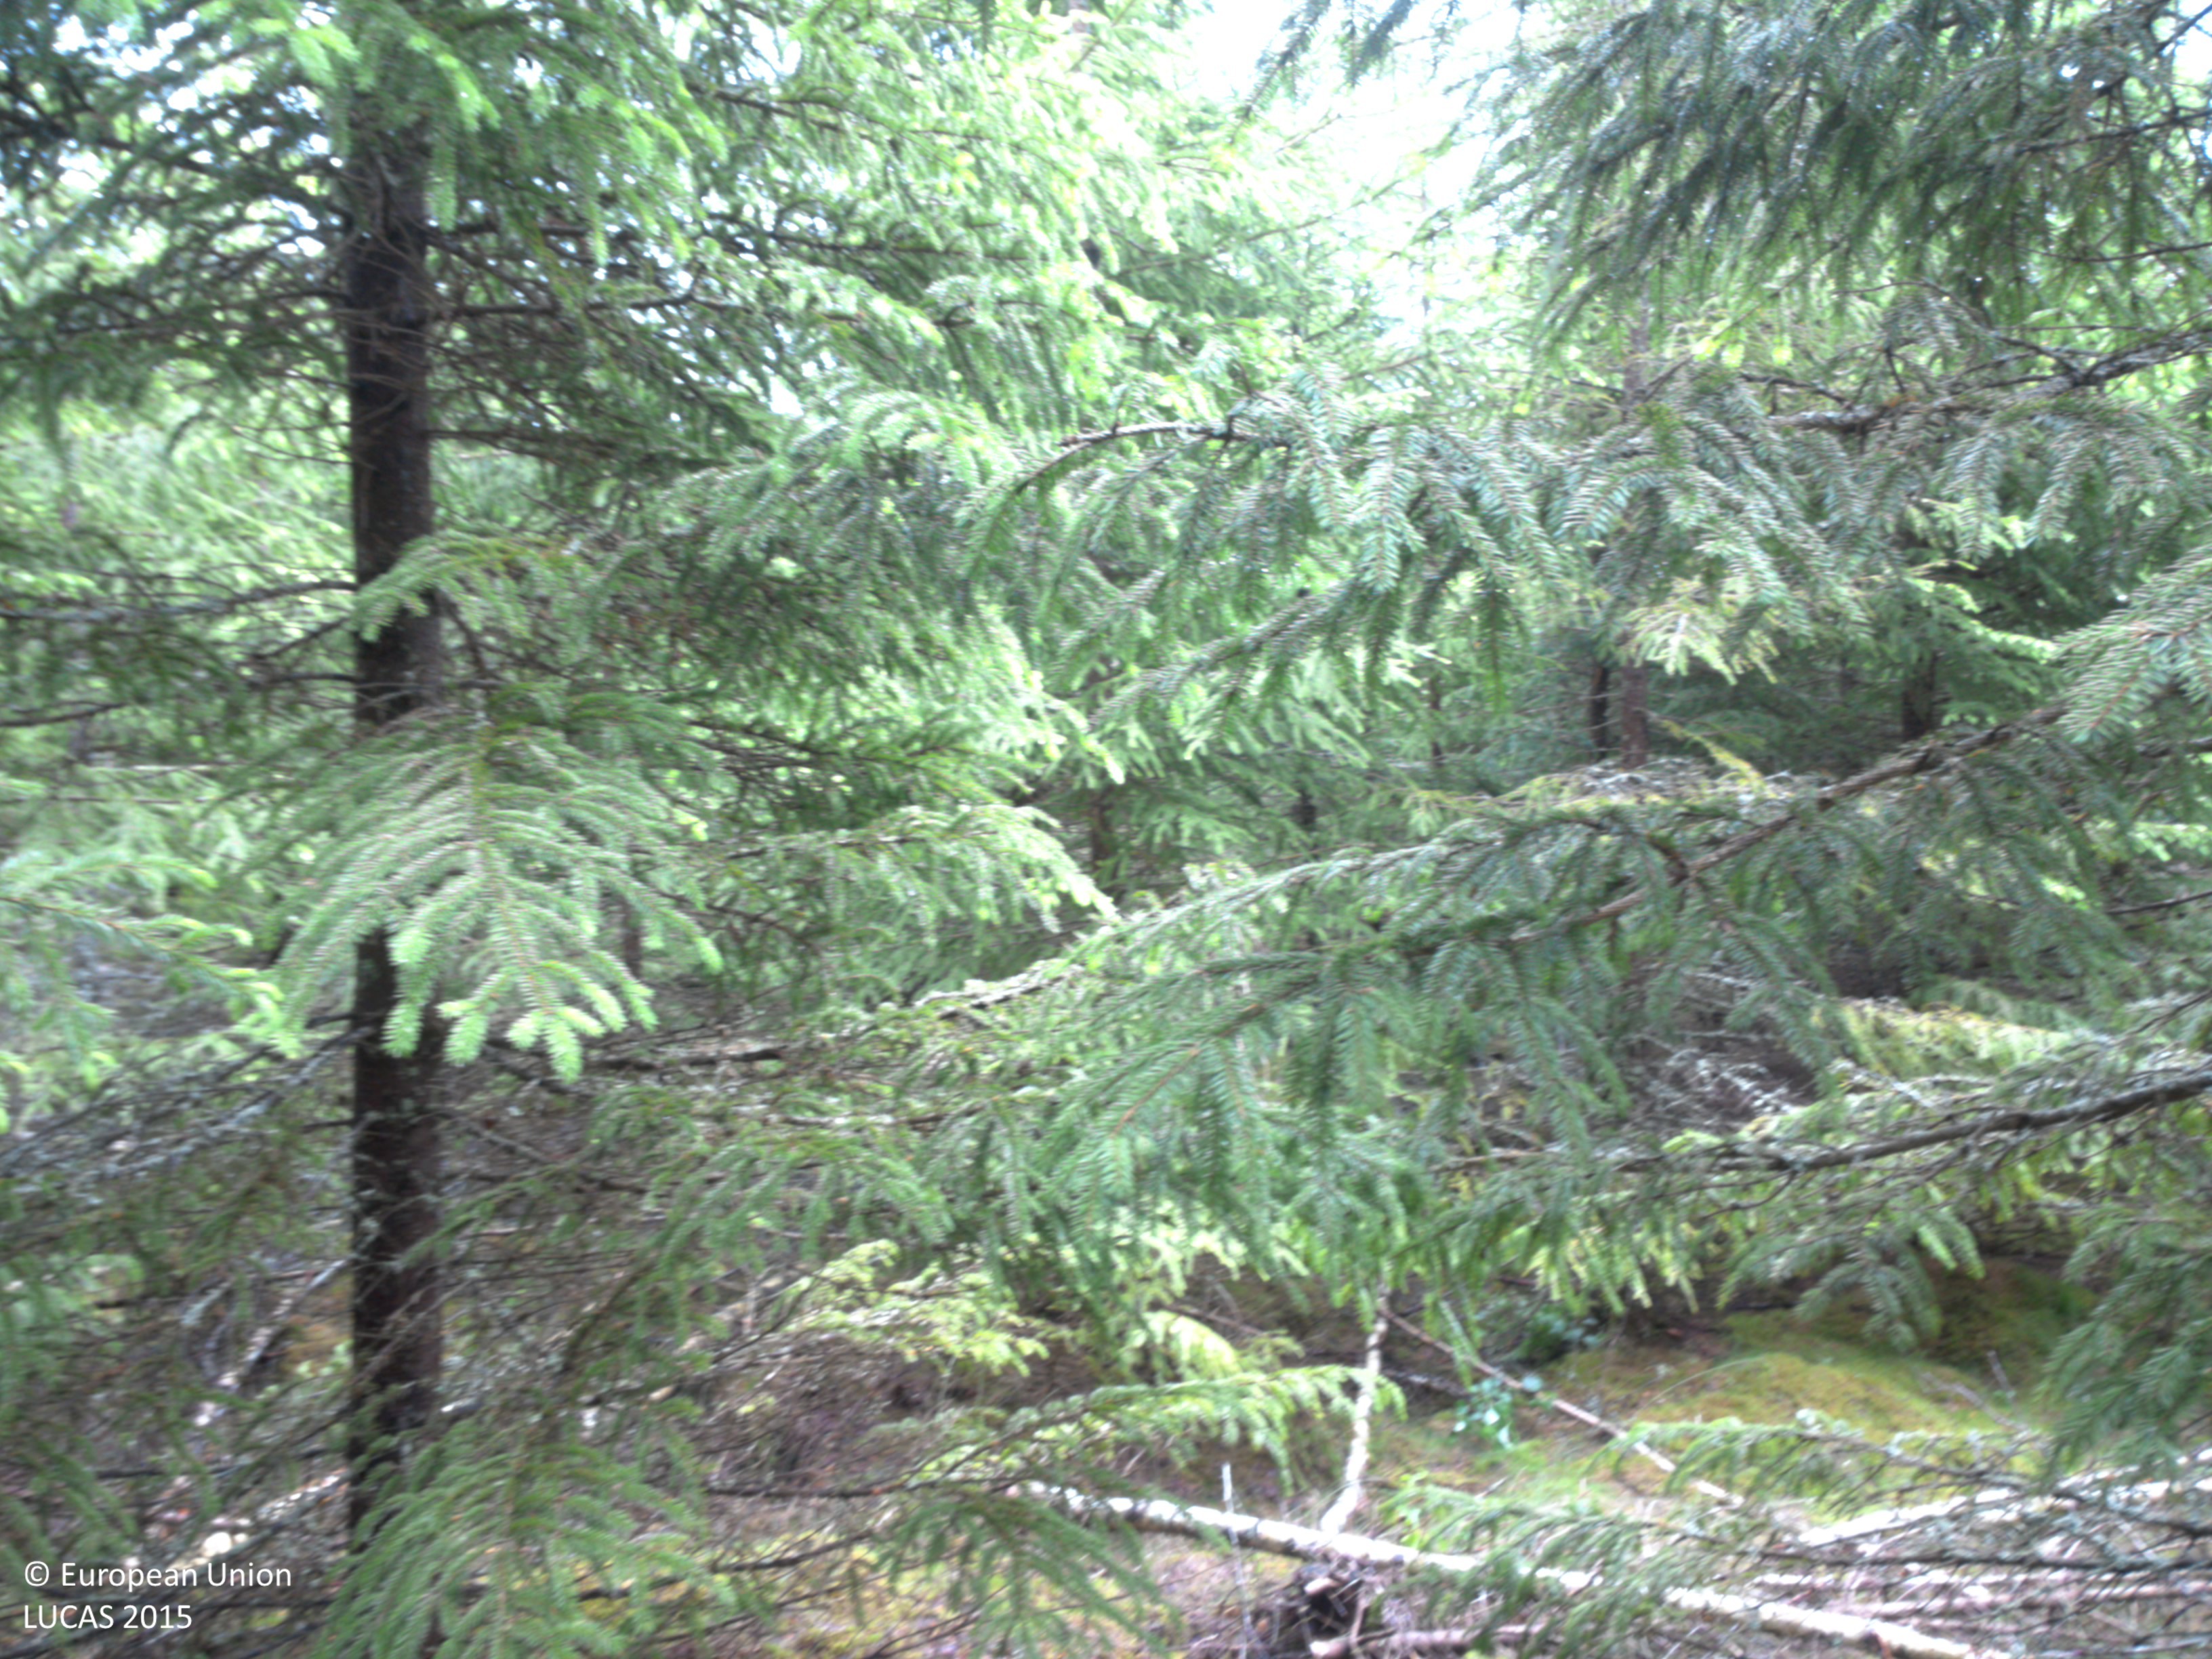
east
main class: Woodland
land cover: Spruce dominated coniferous woodland
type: boreal forest
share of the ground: > 75 %
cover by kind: coniferous forest trees 75 %, lichens and mosses 25 %
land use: Forestry
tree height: < 5 m
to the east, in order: Spruce dominated coniferous woodland; Pine dominated mixed woodland; Railways; Shrubland without tree cover; Spruce dominated coniferous woodland; Paved roads, cycling and walking lanes; Spruce dominated coniferous woodland
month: July
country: SE
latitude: 58.8325
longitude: 12.1260
